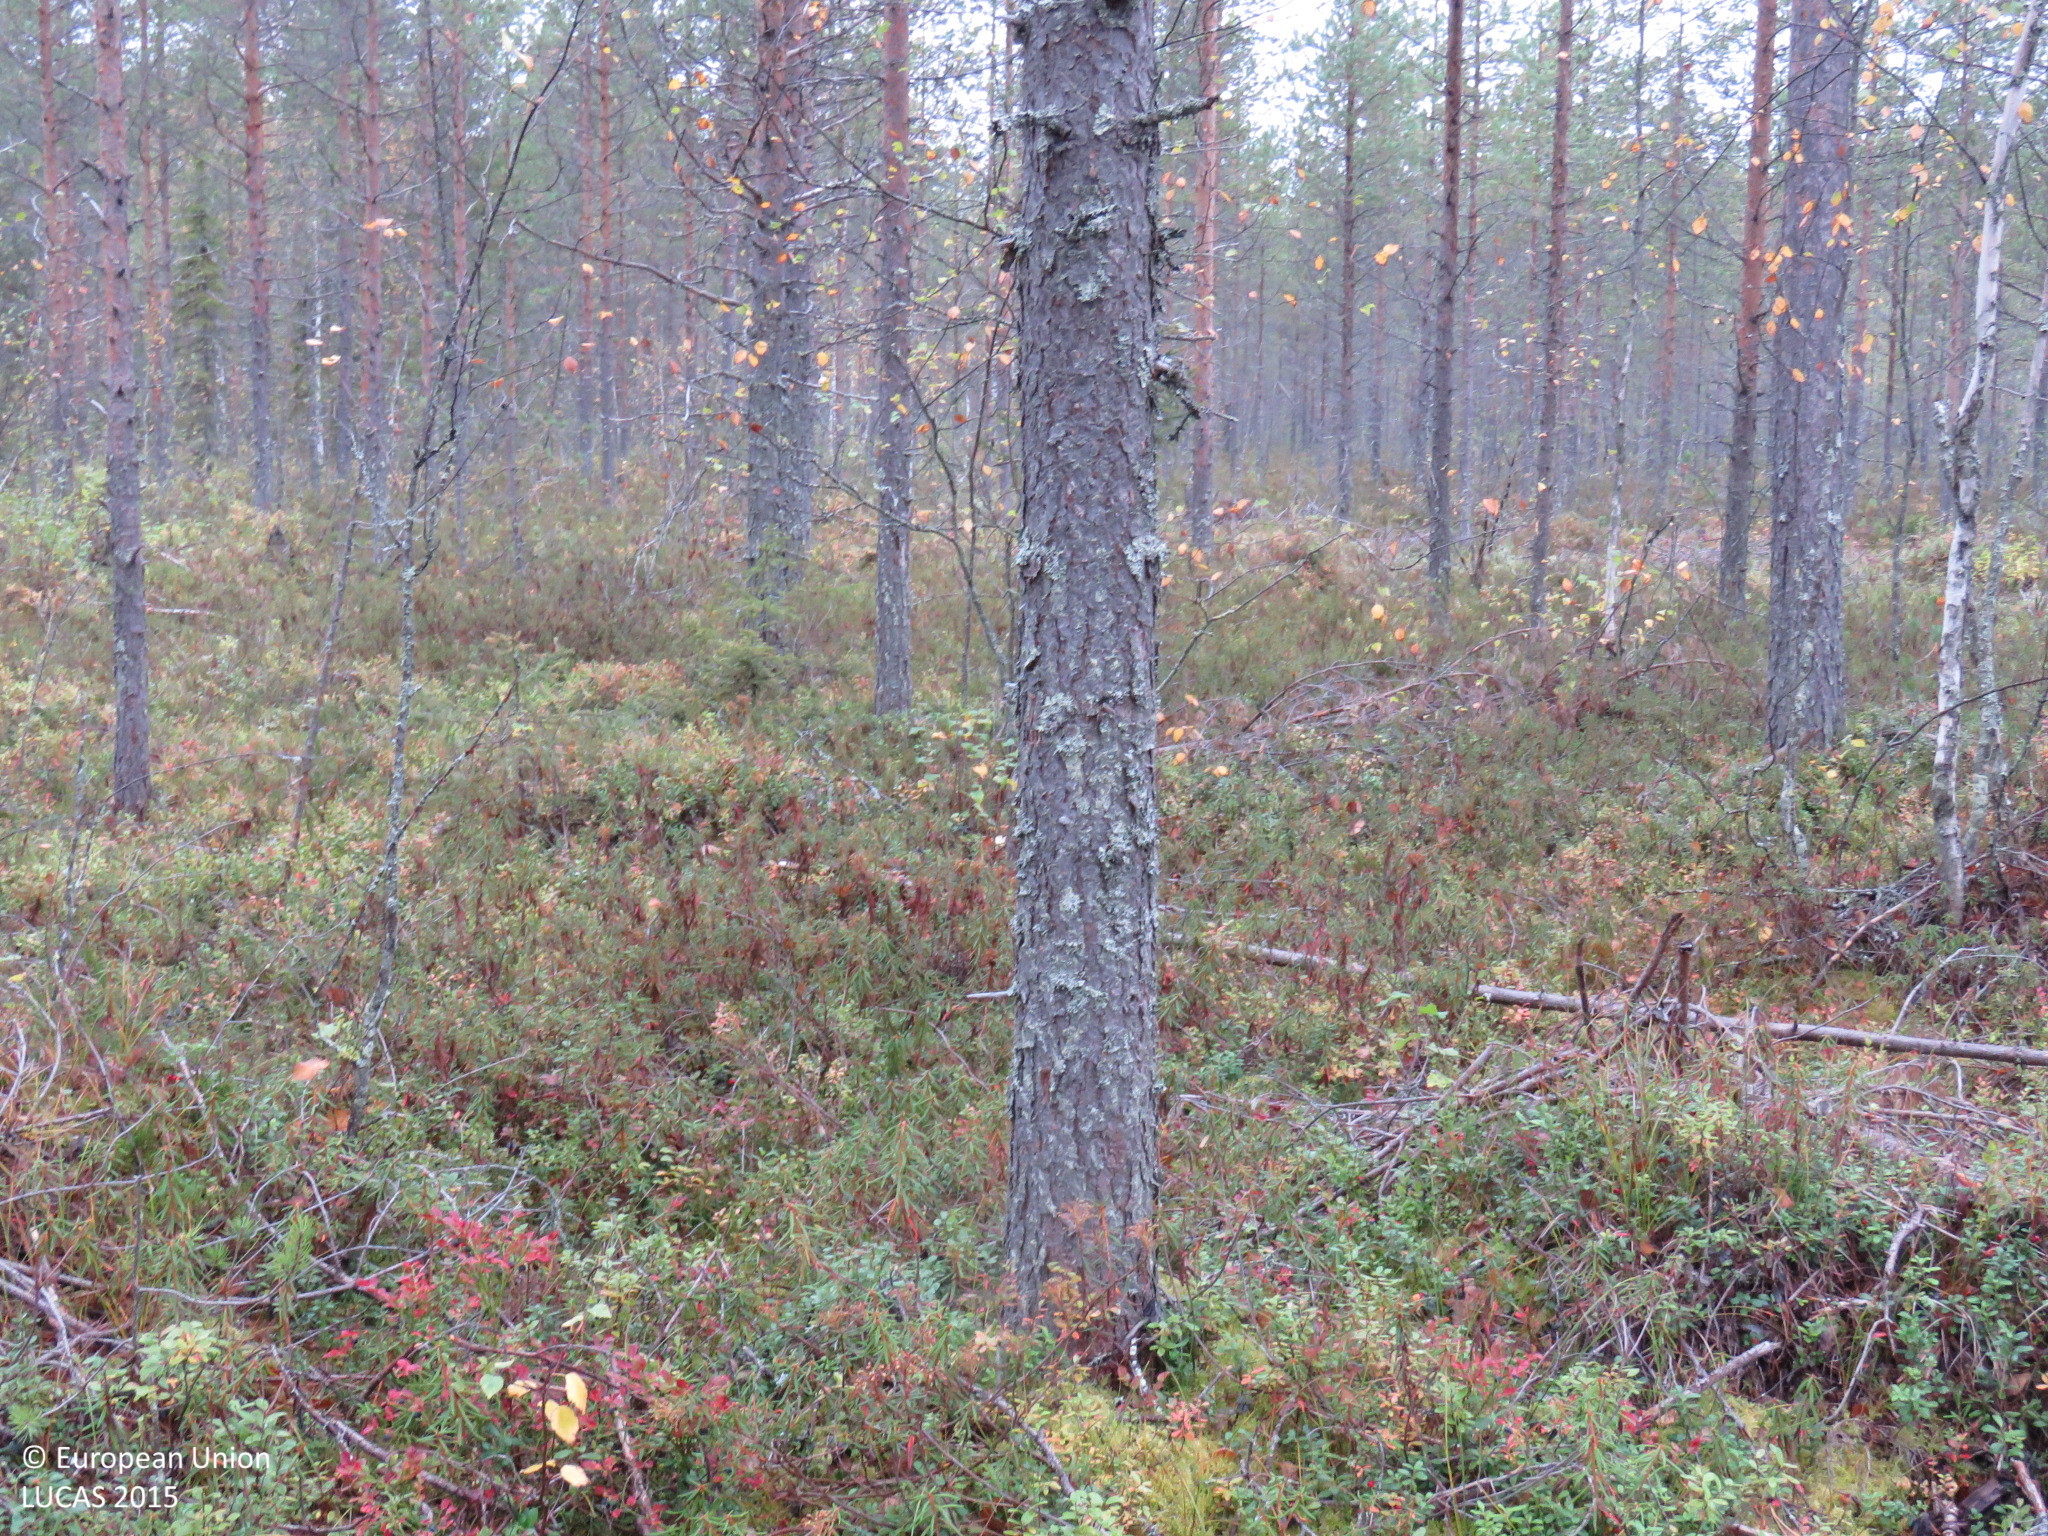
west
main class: Woodland
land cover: Pine dominated coniferous woodland
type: boreal forest
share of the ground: 50 - 75 %
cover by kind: coniferous forest trees 65 %, shrubs 20 %, lichens and mosses 10 %, broadleaved forest trees 5 %
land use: Forestry
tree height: > 5 m
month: September
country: FI
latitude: 64.8482
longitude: 26.9716
